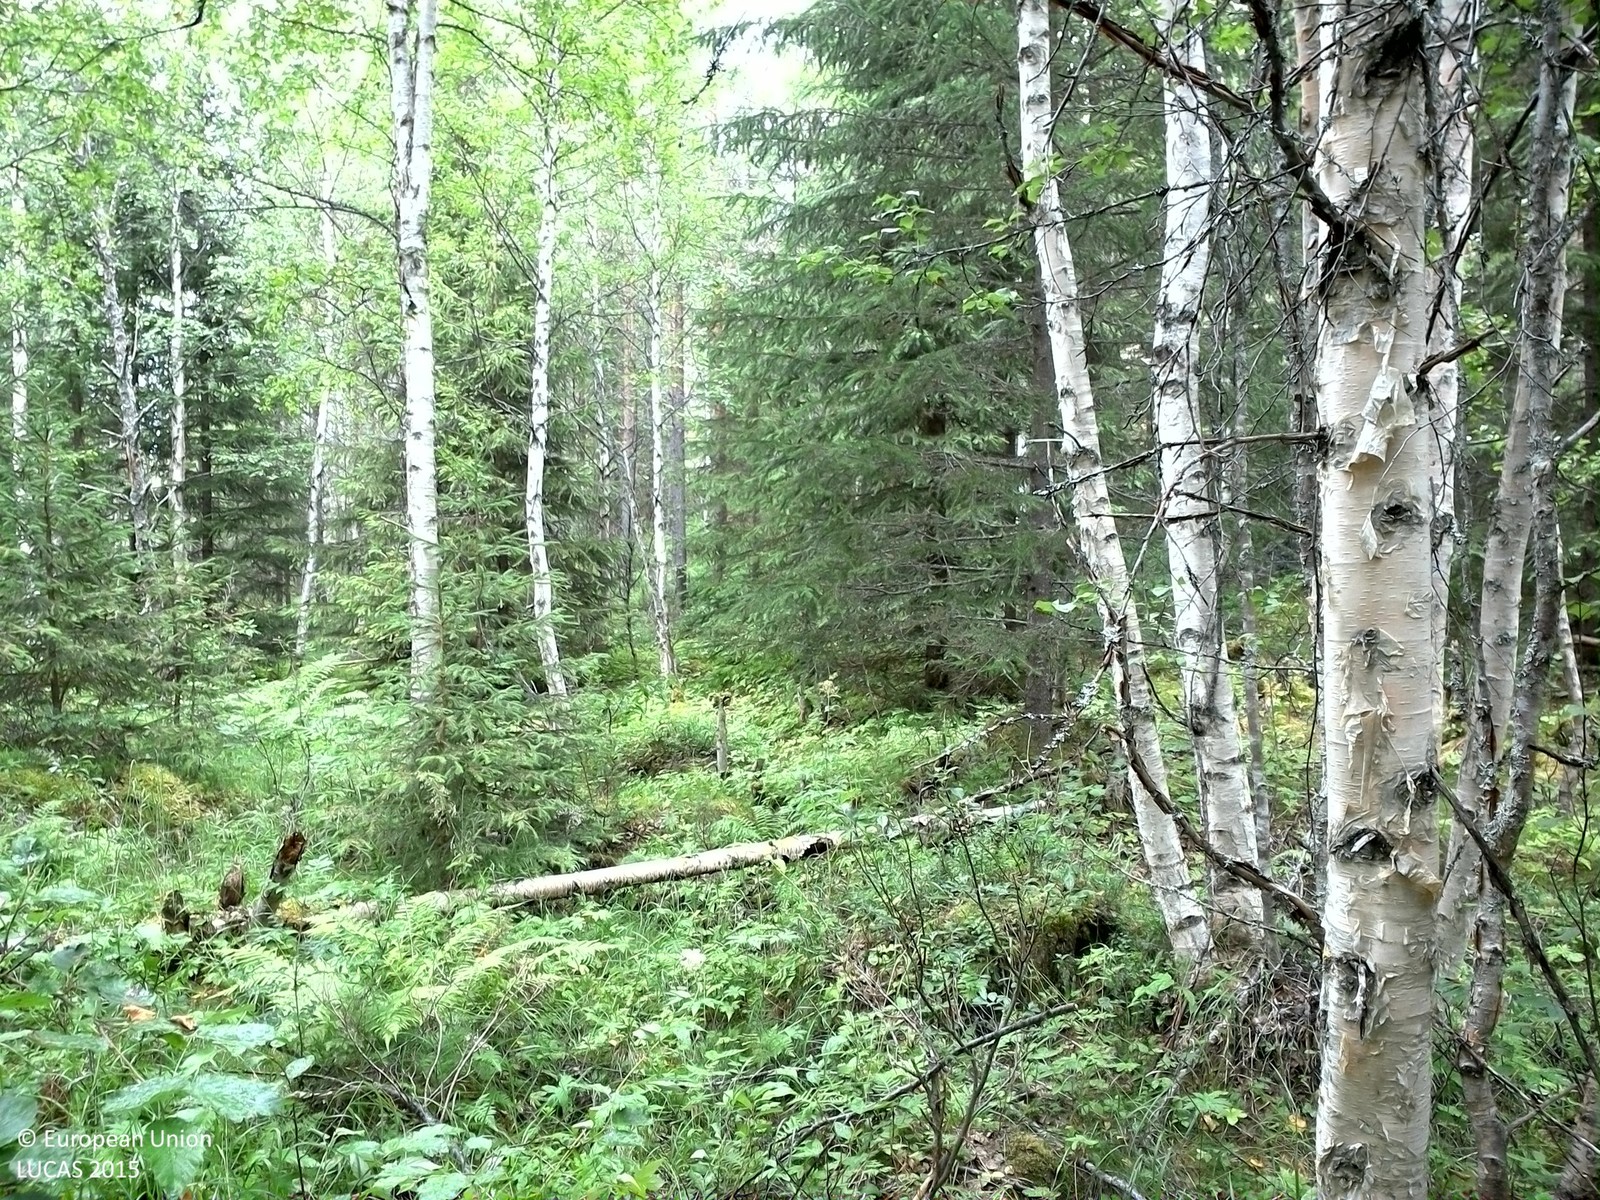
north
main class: Woodland
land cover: Spruce dominated mixed woodland
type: boreal forest
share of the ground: > 75 %
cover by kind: coniferous forest trees 45 %, broadleaved forest trees 40 %, herbaceous plants 15 %
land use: Forestry
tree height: > 5 m
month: August
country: SE
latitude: 63.6415
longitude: 18.1906
